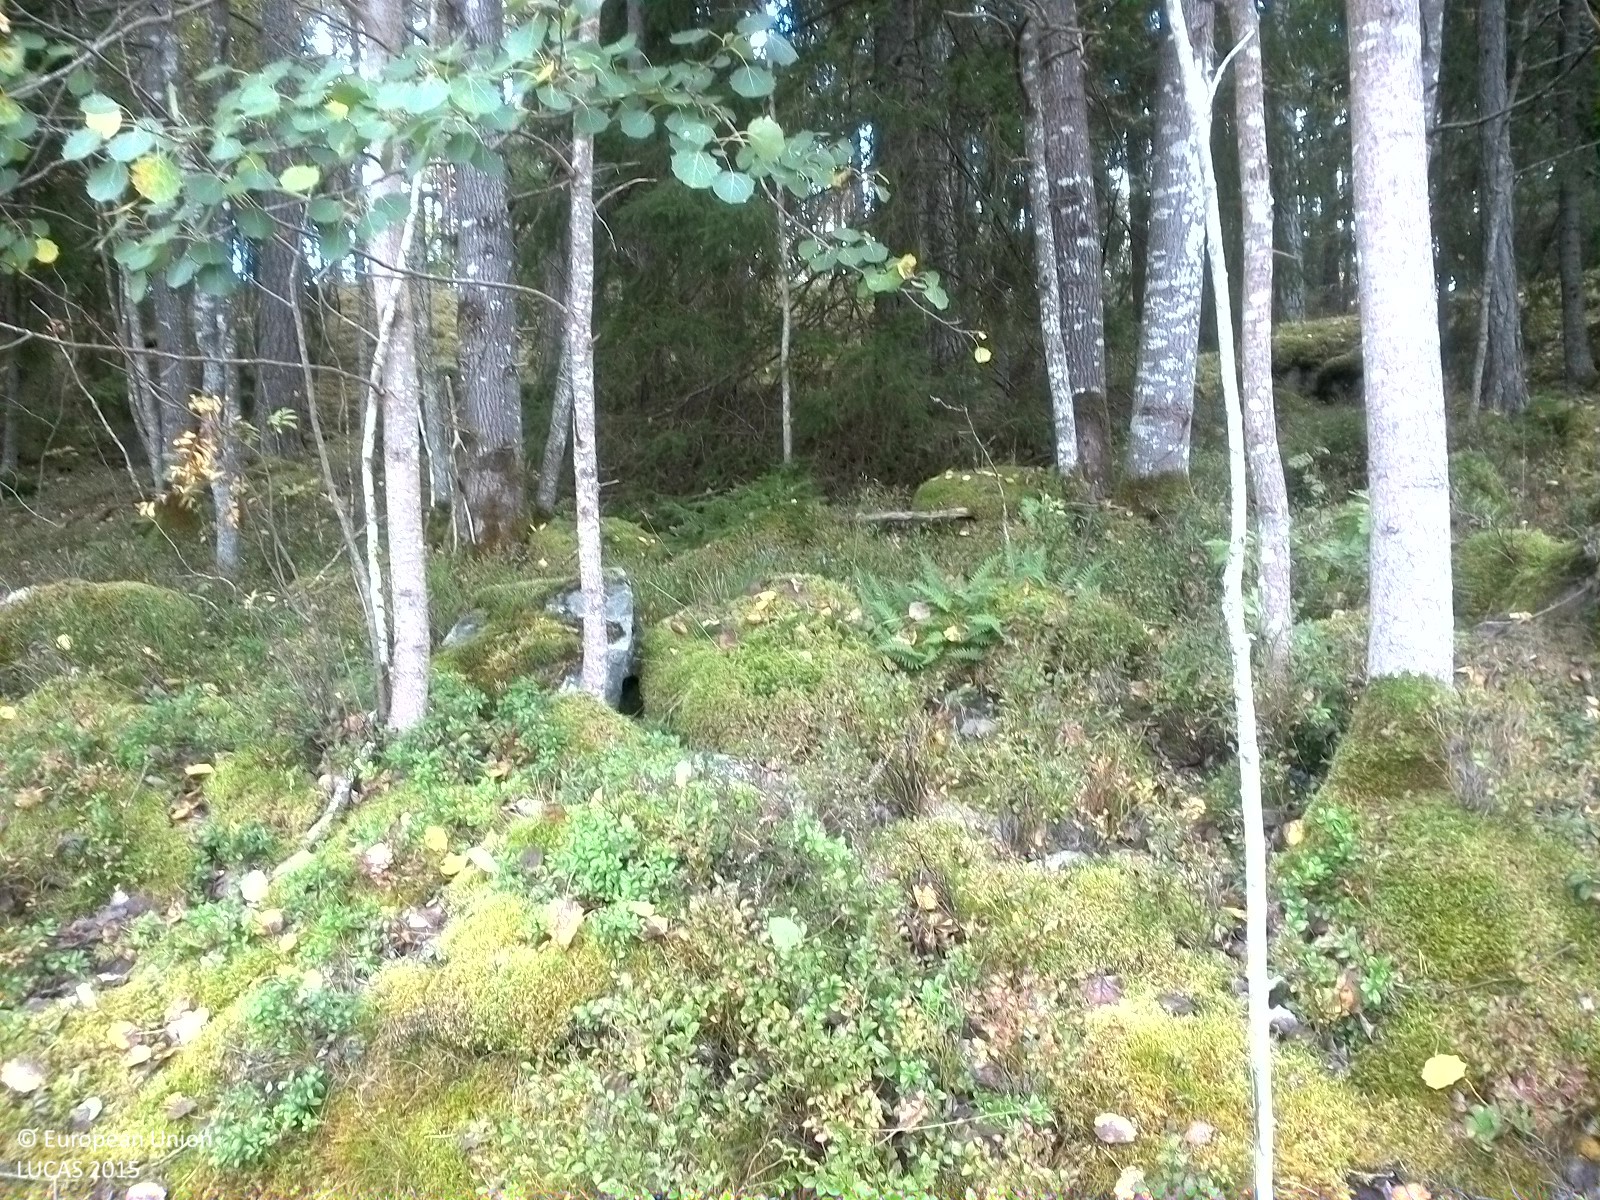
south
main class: Cropland
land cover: Barley
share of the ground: > 75 %
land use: Agriculture (excluding fallow land and kitchen gardens)
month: September
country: SE
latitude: 58.6507
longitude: 17.0110
